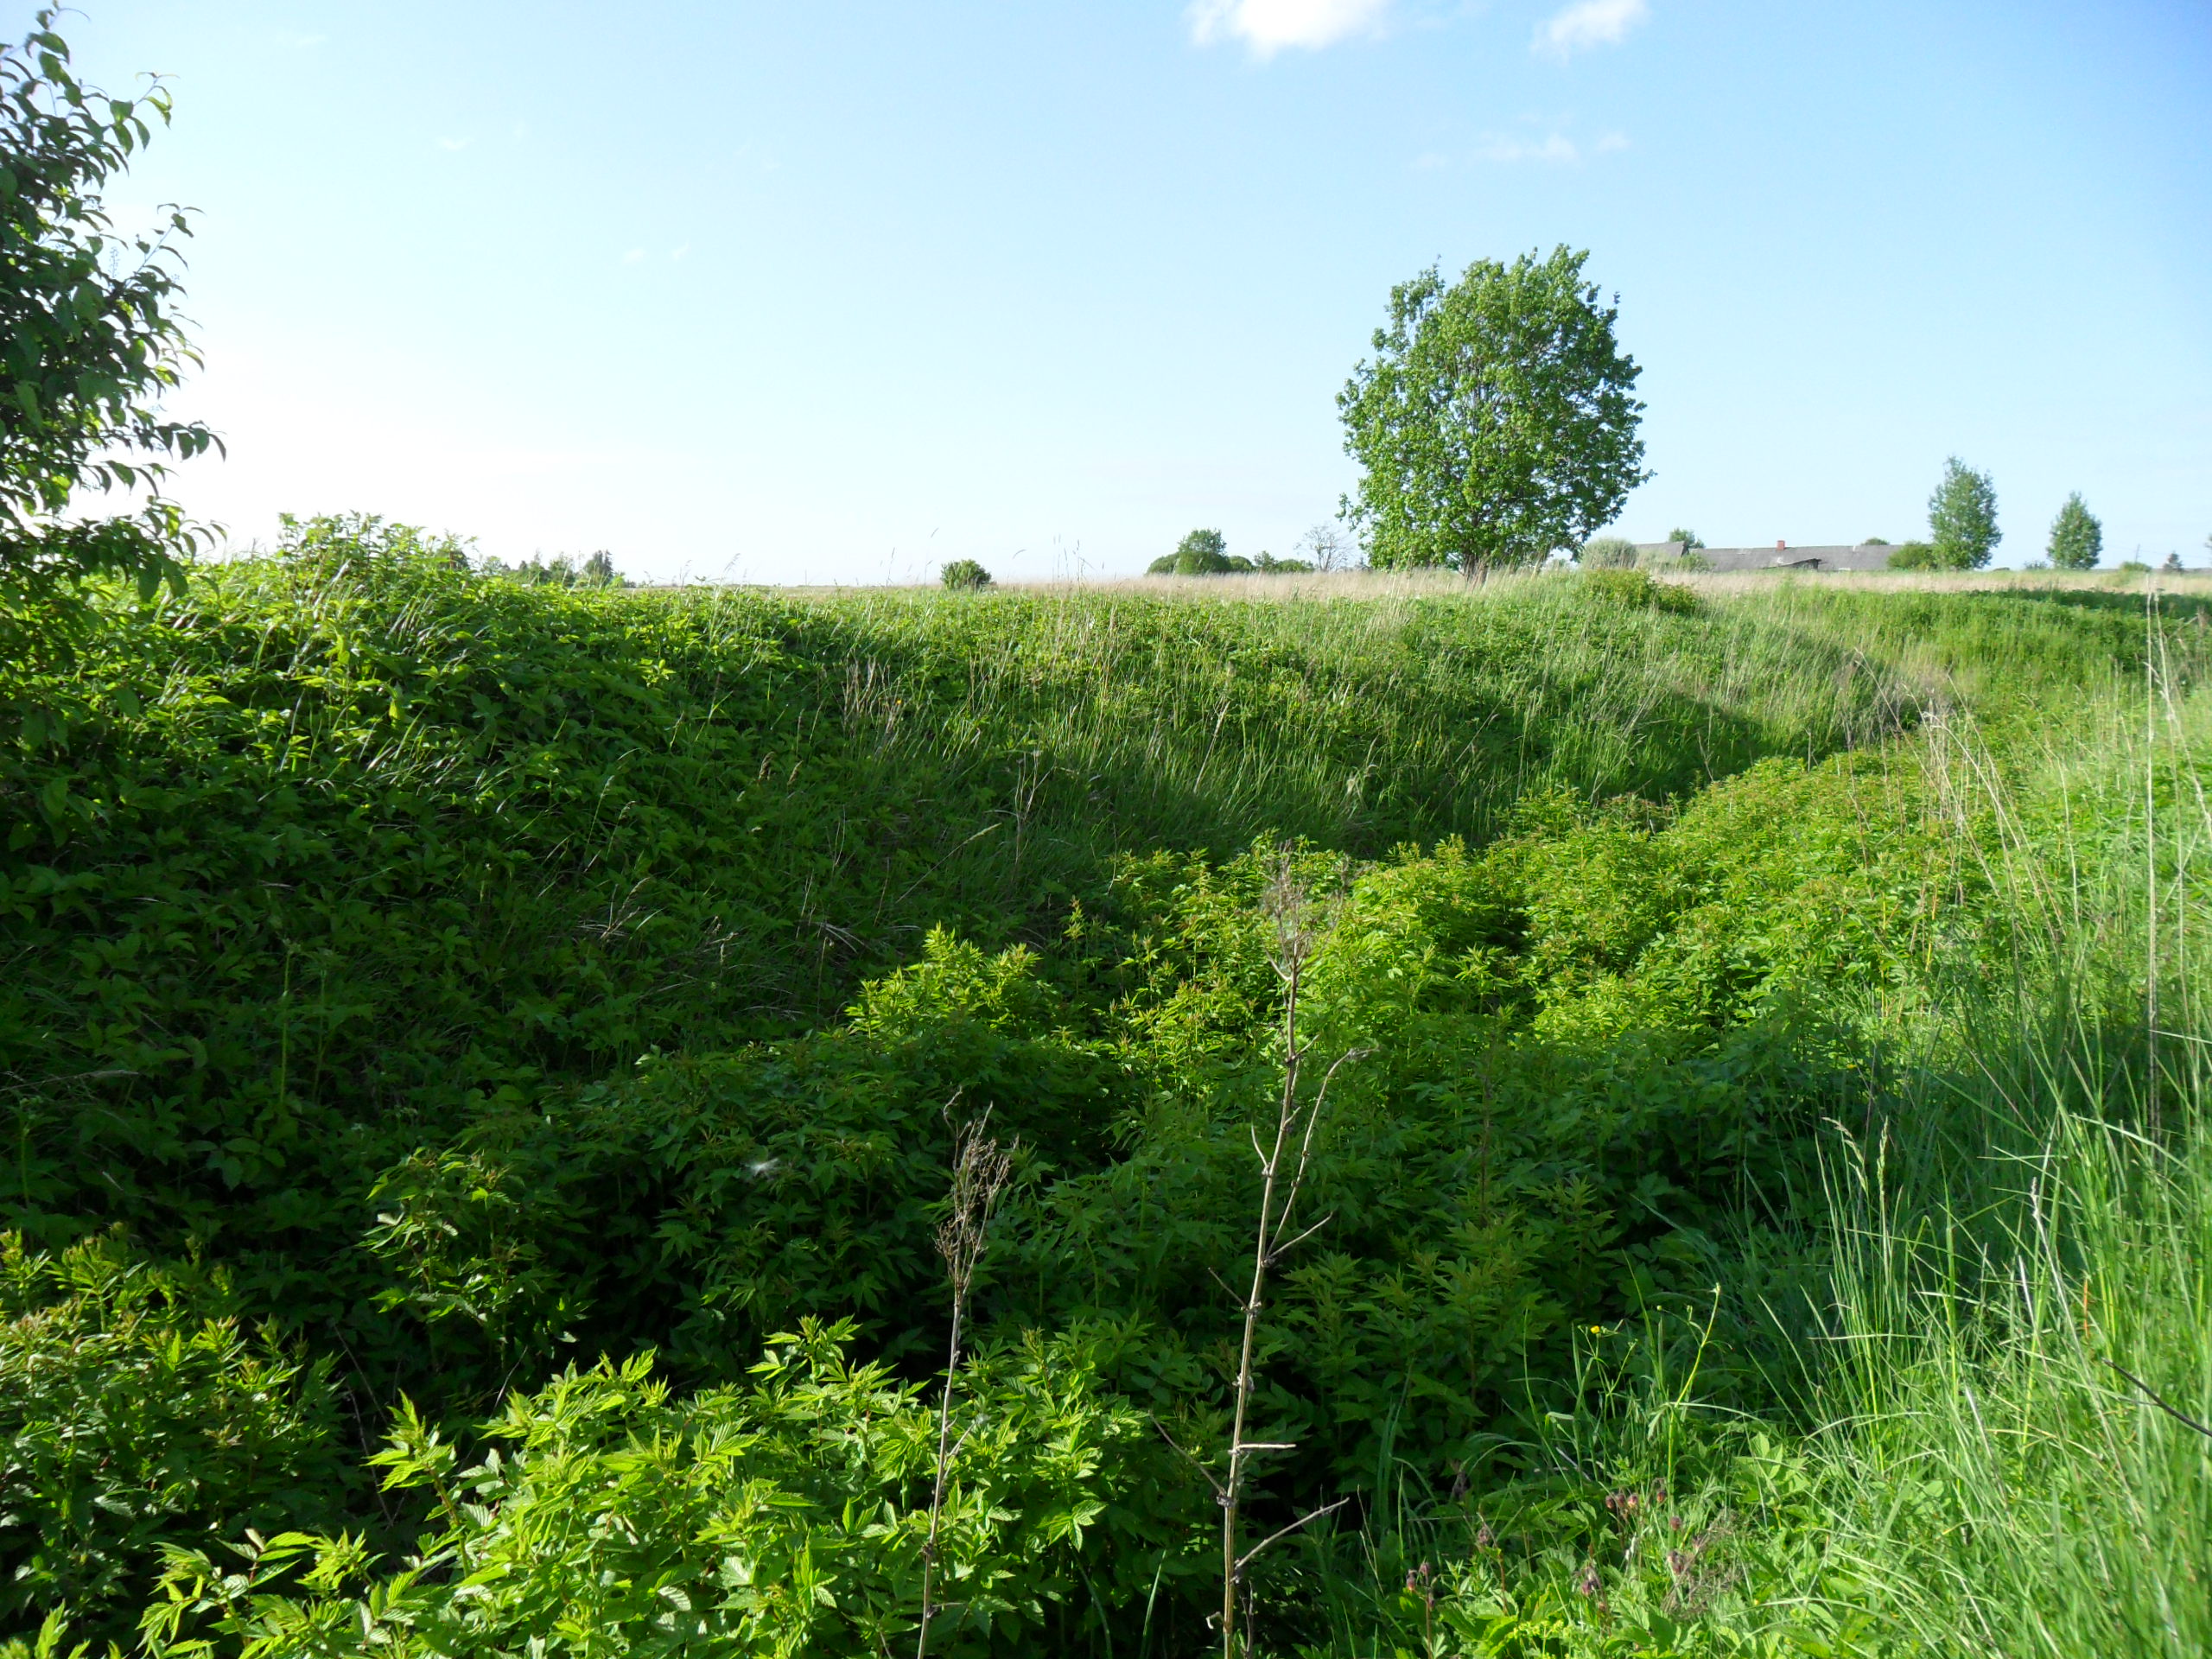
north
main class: Grassland
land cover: Grassland without tree/shrub cover
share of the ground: > 75 %
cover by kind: herbaceous plants 100 %
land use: Agriculture (excluding fallow land and kitchen gardens)
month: June
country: LV
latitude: 57.3654
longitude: 22.4388
